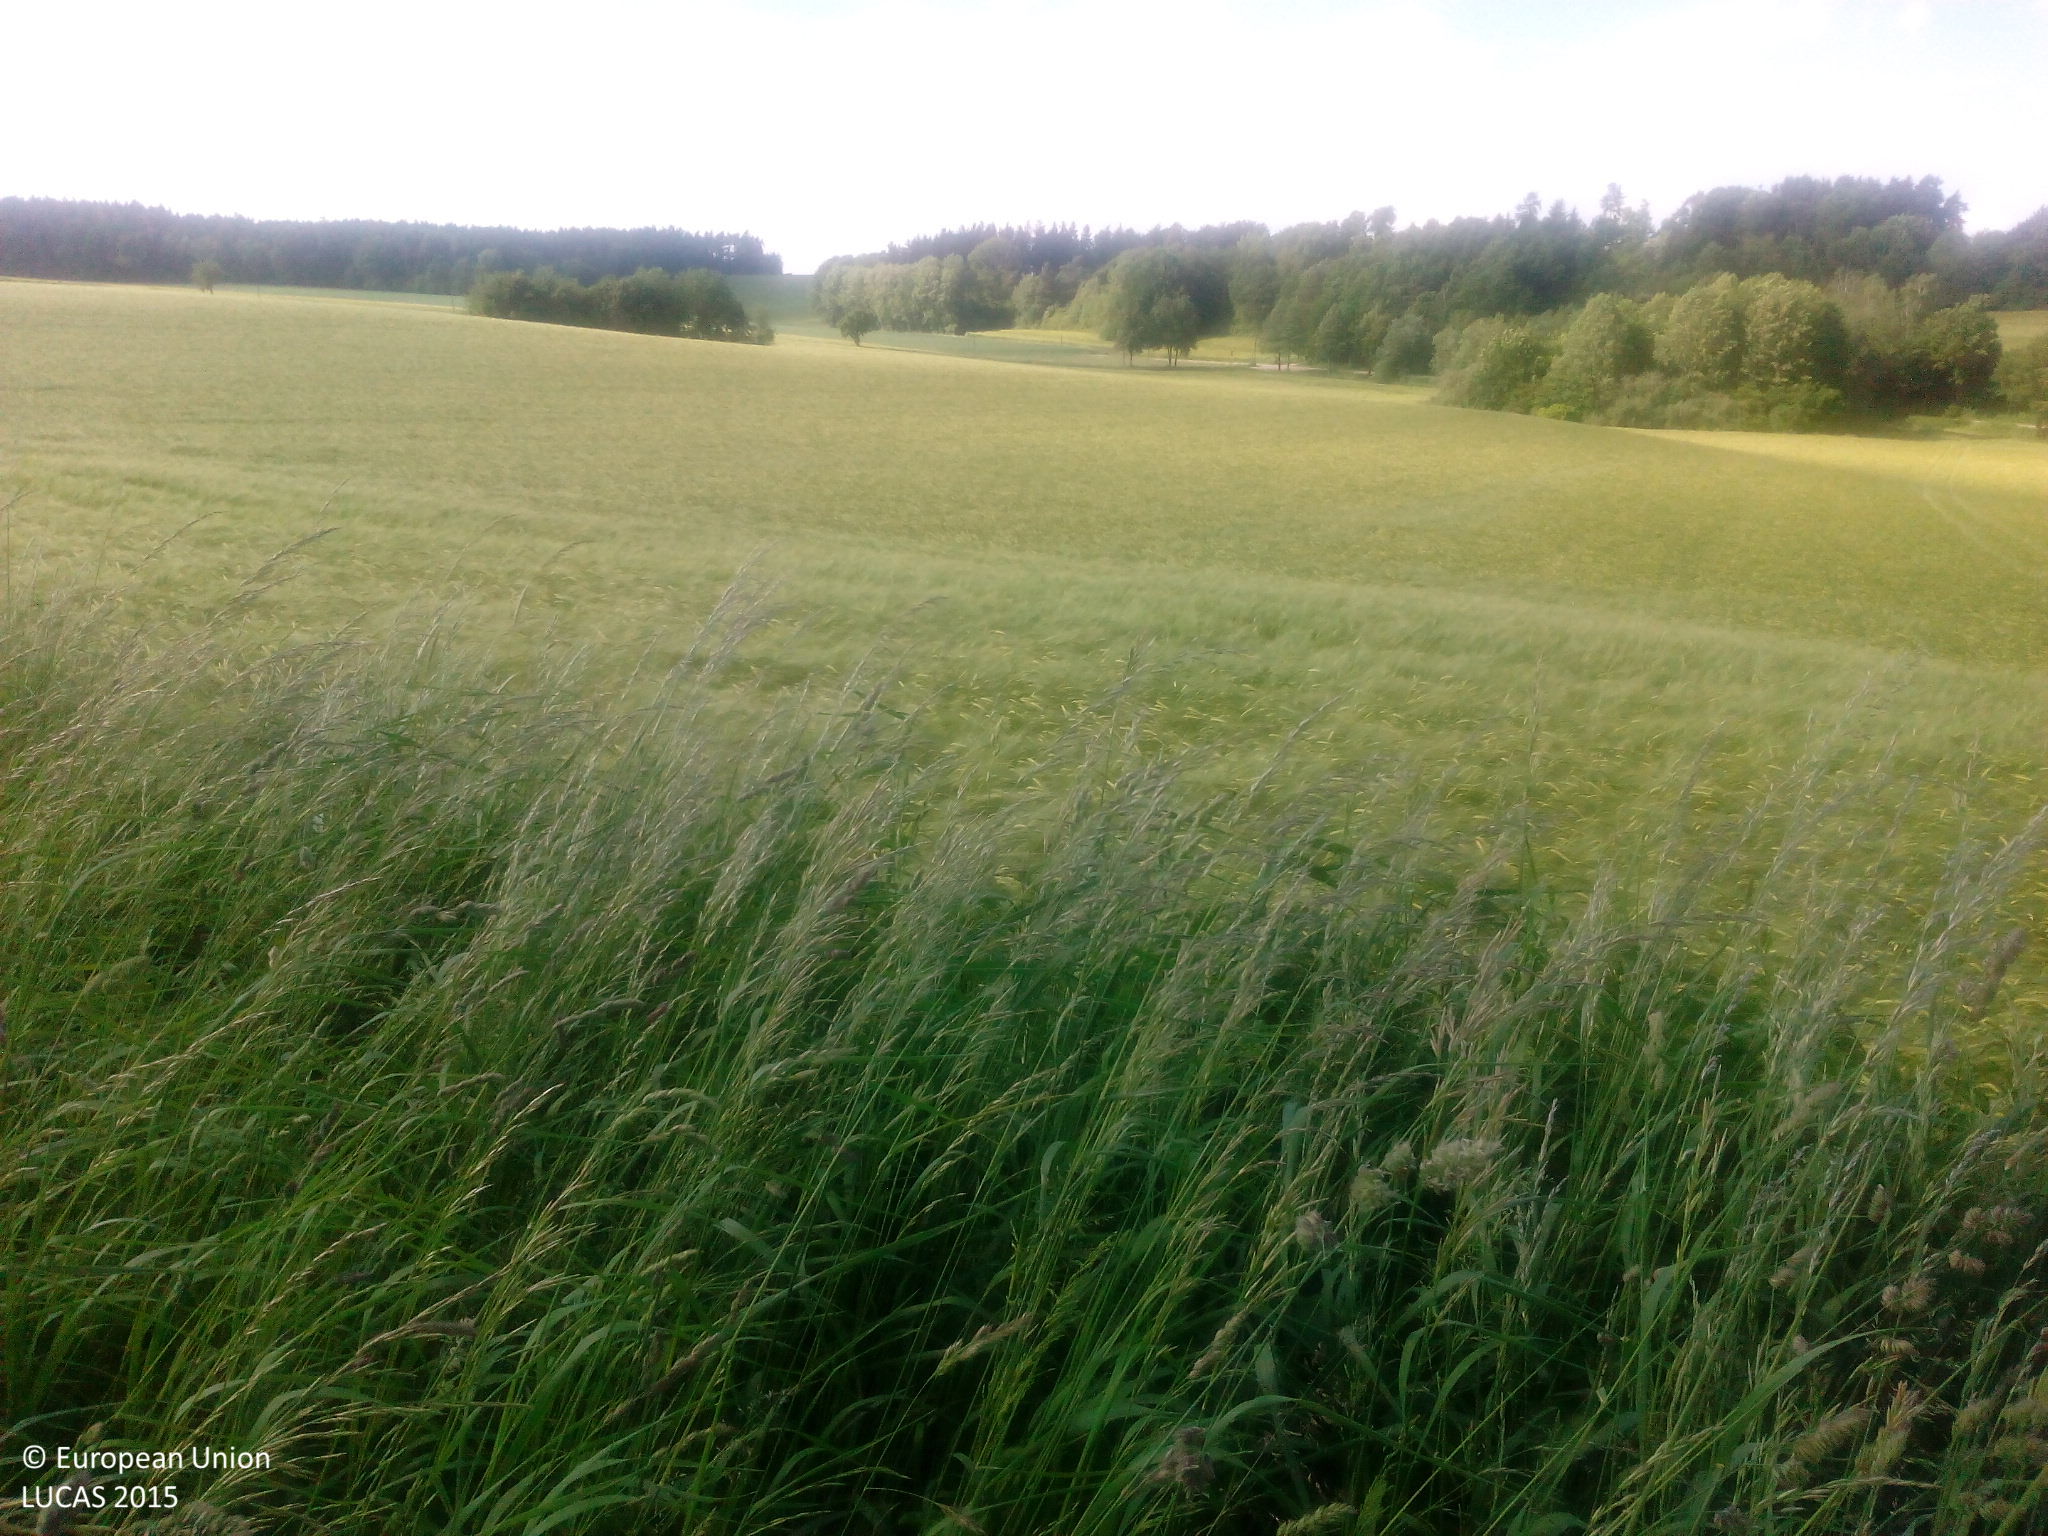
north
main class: Cropland
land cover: Rye
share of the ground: > 75 %
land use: Agriculture (excluding fallow land and kitchen gardens)
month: June
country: DE
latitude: 48.7439
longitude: 12.0799
